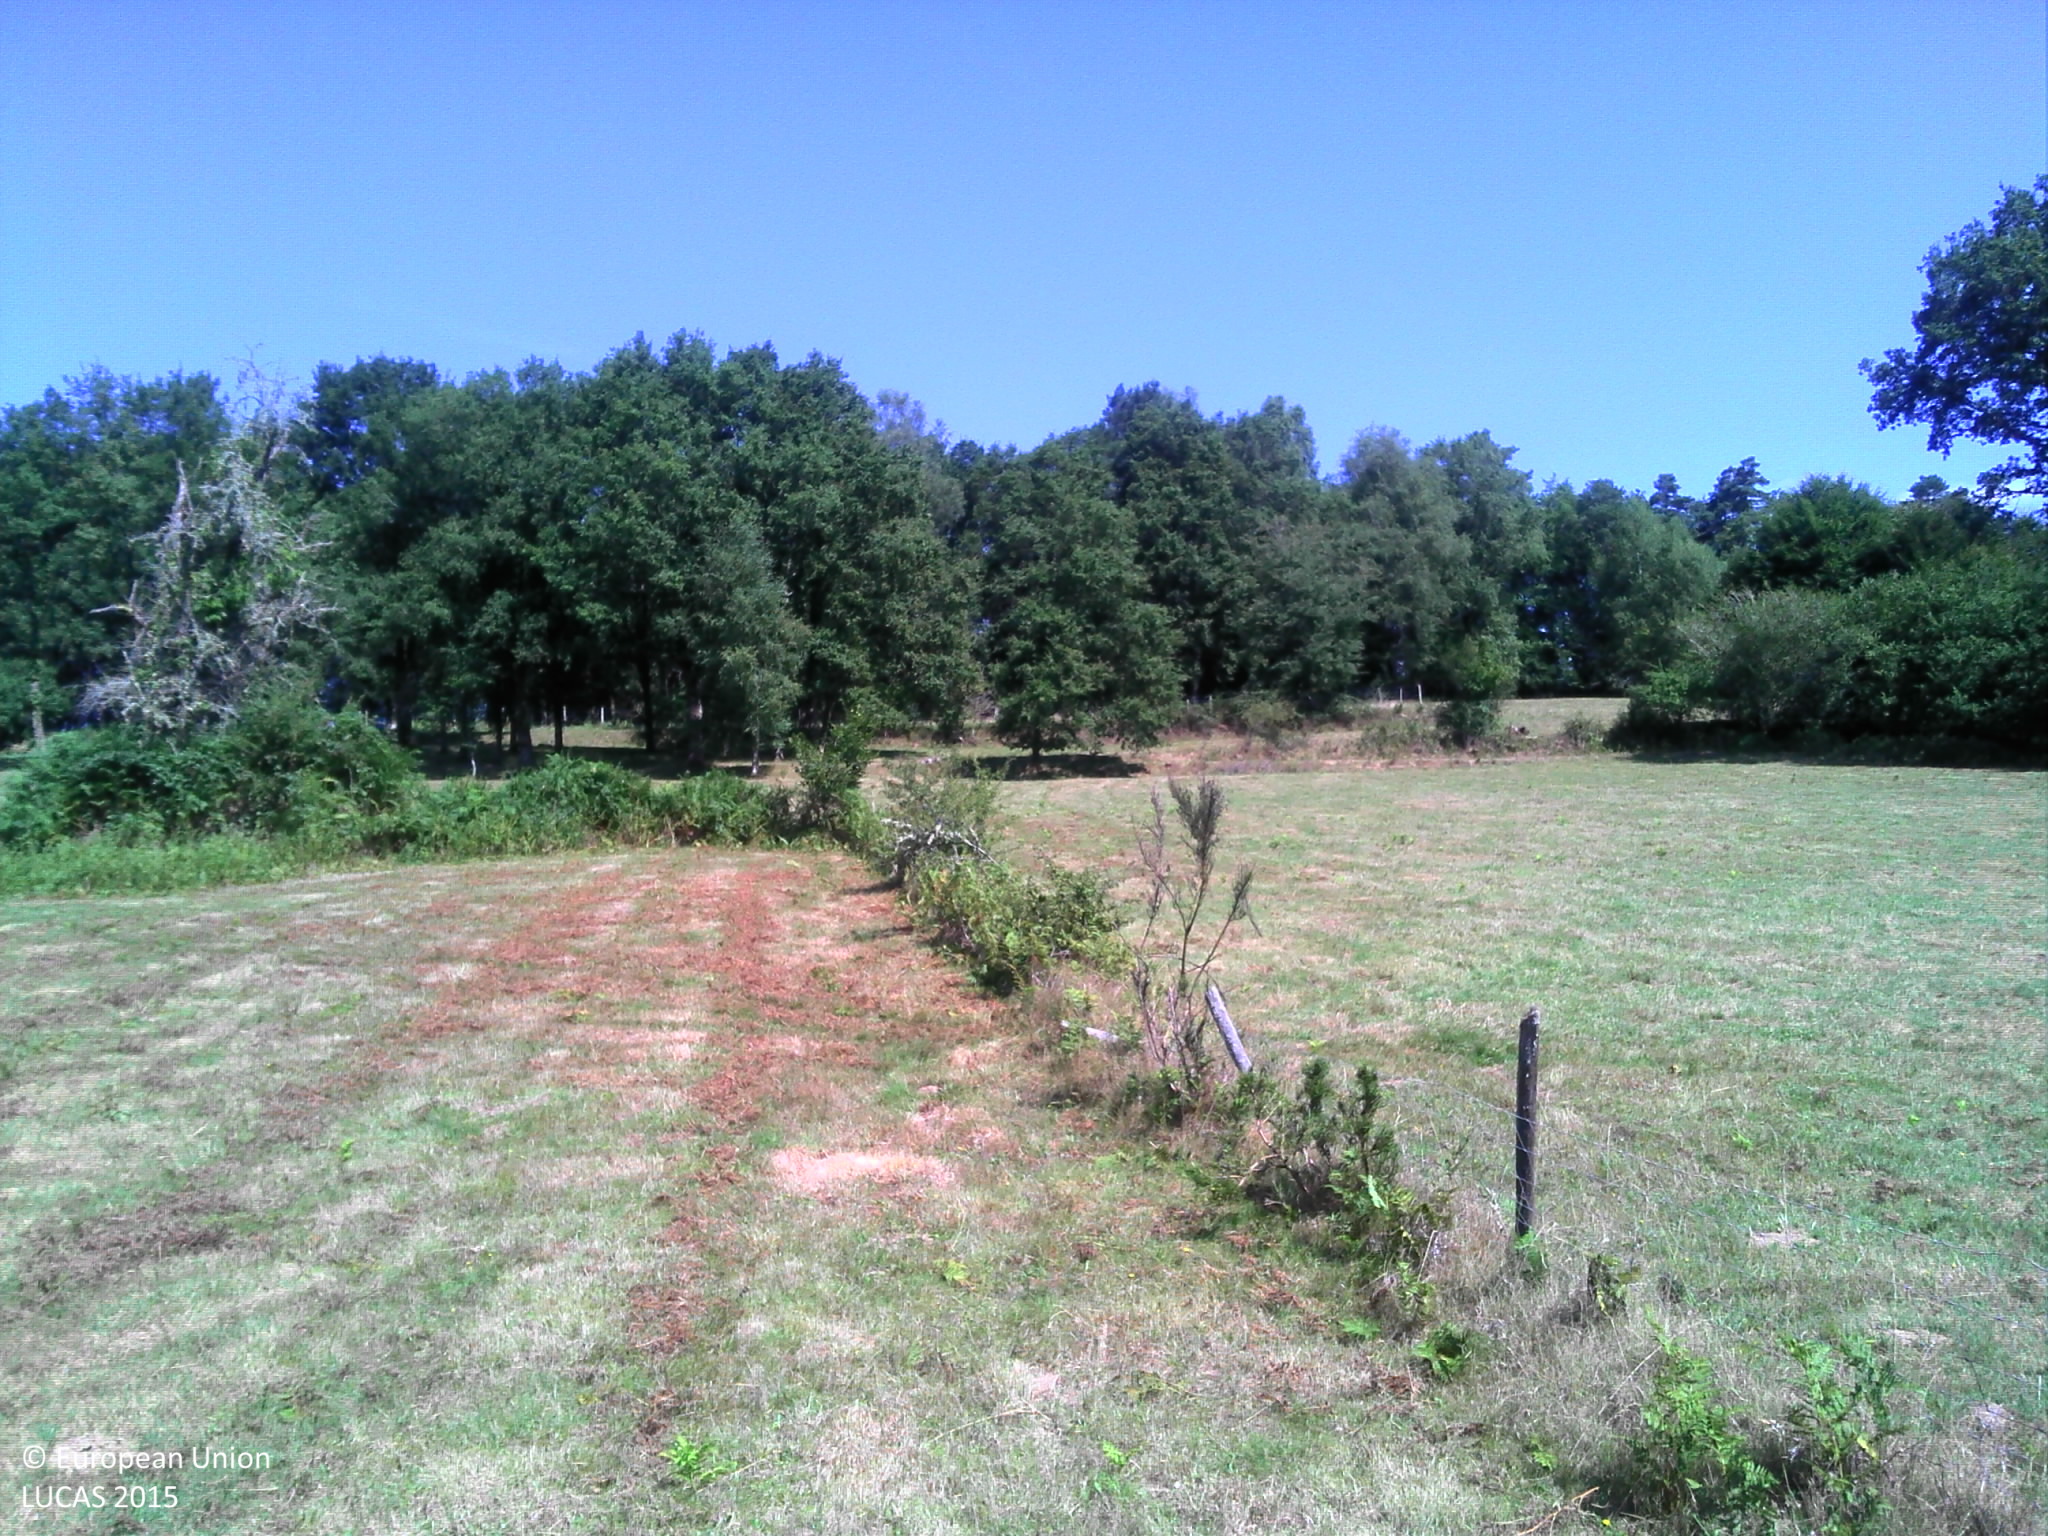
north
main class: Grassland
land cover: Grassland without tree/shrub cover
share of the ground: > 75 %
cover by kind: herbaceous plants 100 %
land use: Agriculture (excluding fallow land and kitchen gardens)
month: August
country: FR
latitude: 45.8204
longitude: 1.8211
